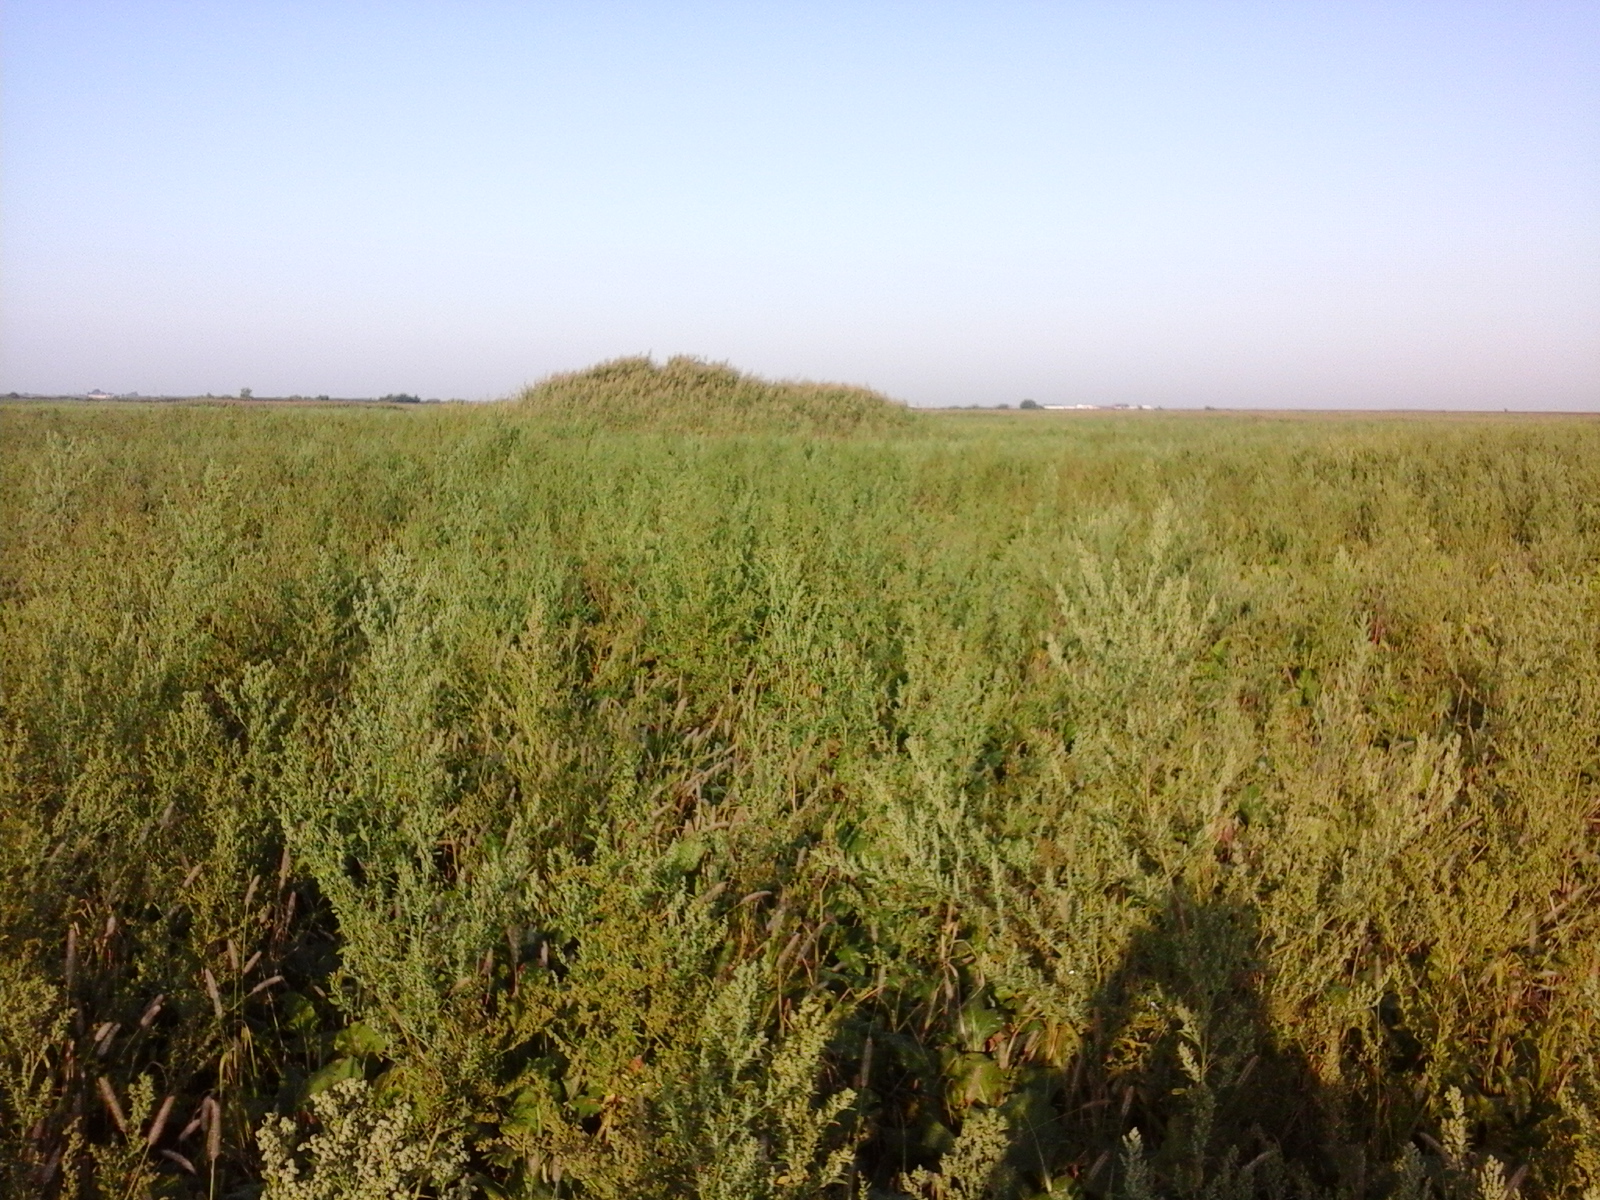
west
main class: Cropland
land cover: Sugar beet
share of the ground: 10 - 25 %
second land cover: Spontaneously vegetated surfaces
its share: > 75 %
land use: Agriculture (excluding fallow land and kitchen gardens)
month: August
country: RO
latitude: 45.7946
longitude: 21.0541
